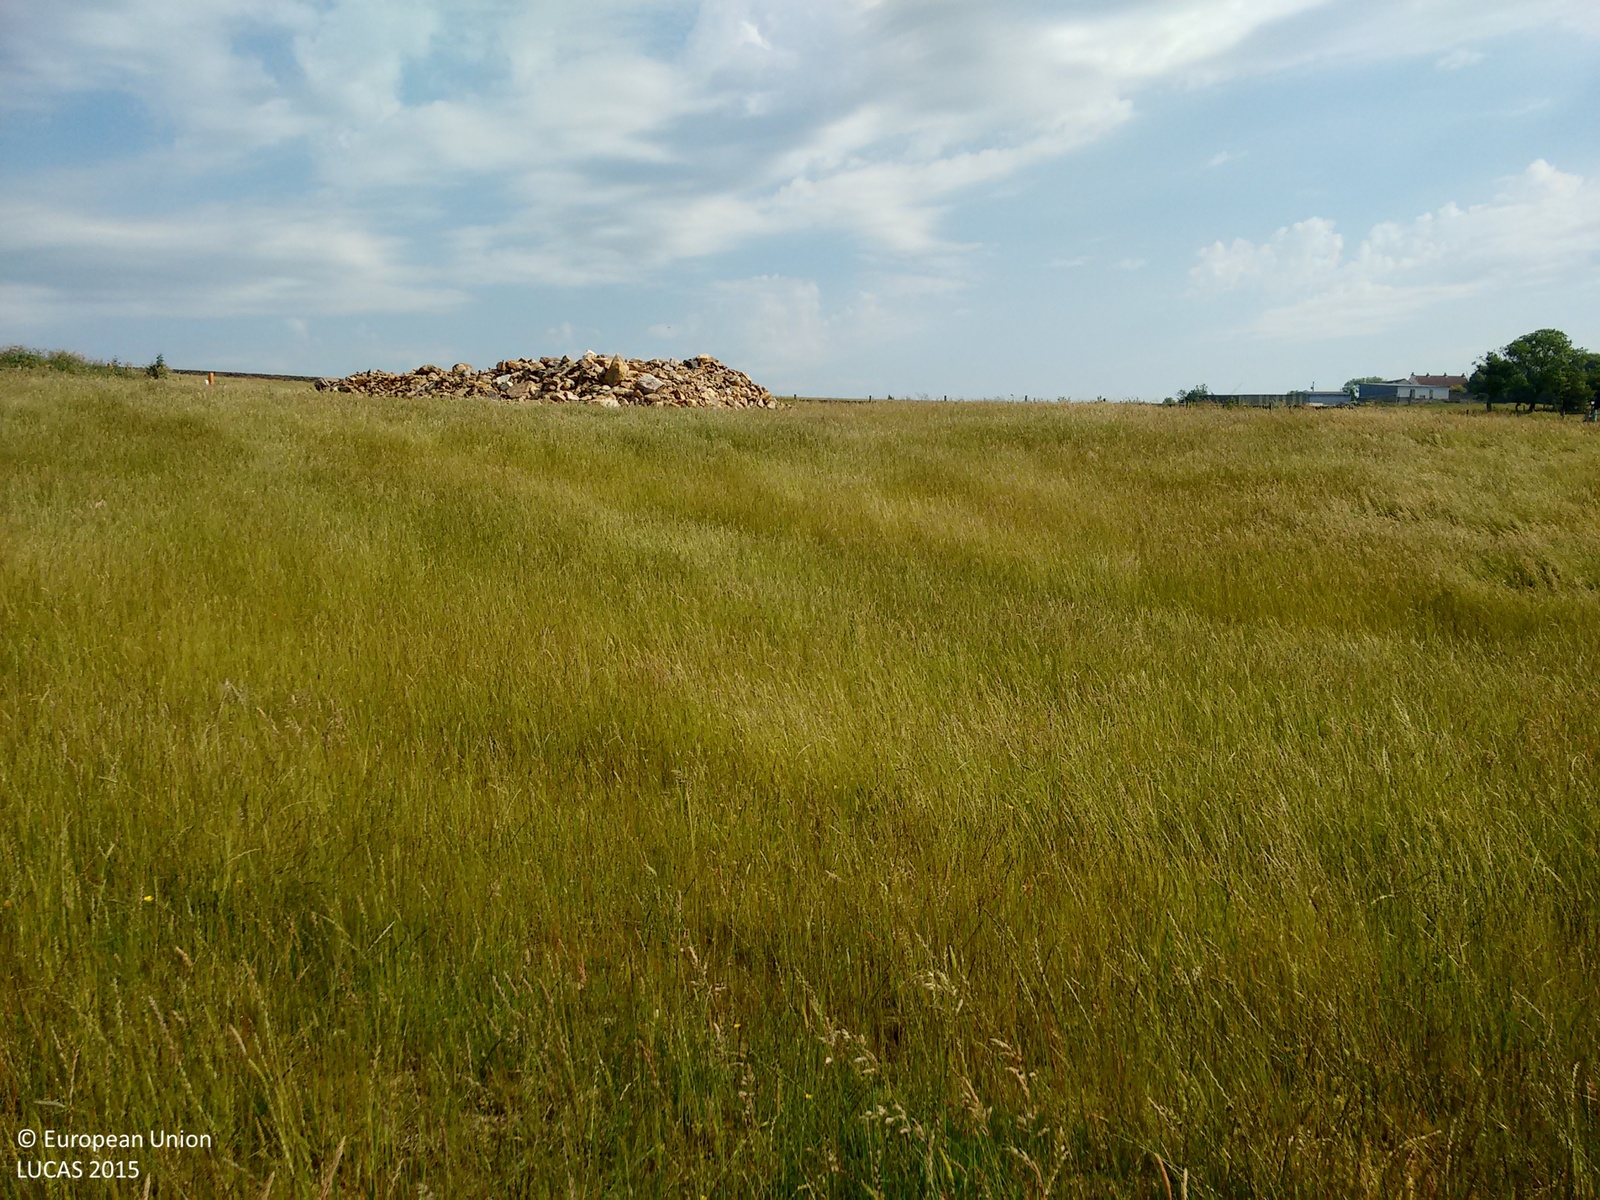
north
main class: Grassland
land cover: Grassland without tree/shrub cover
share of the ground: > 75 %
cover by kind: herbaceous plants 100 %
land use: Agriculture (excluding fallow land and kitchen gardens)
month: July
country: GB
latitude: 54.7338
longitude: -1.7772
